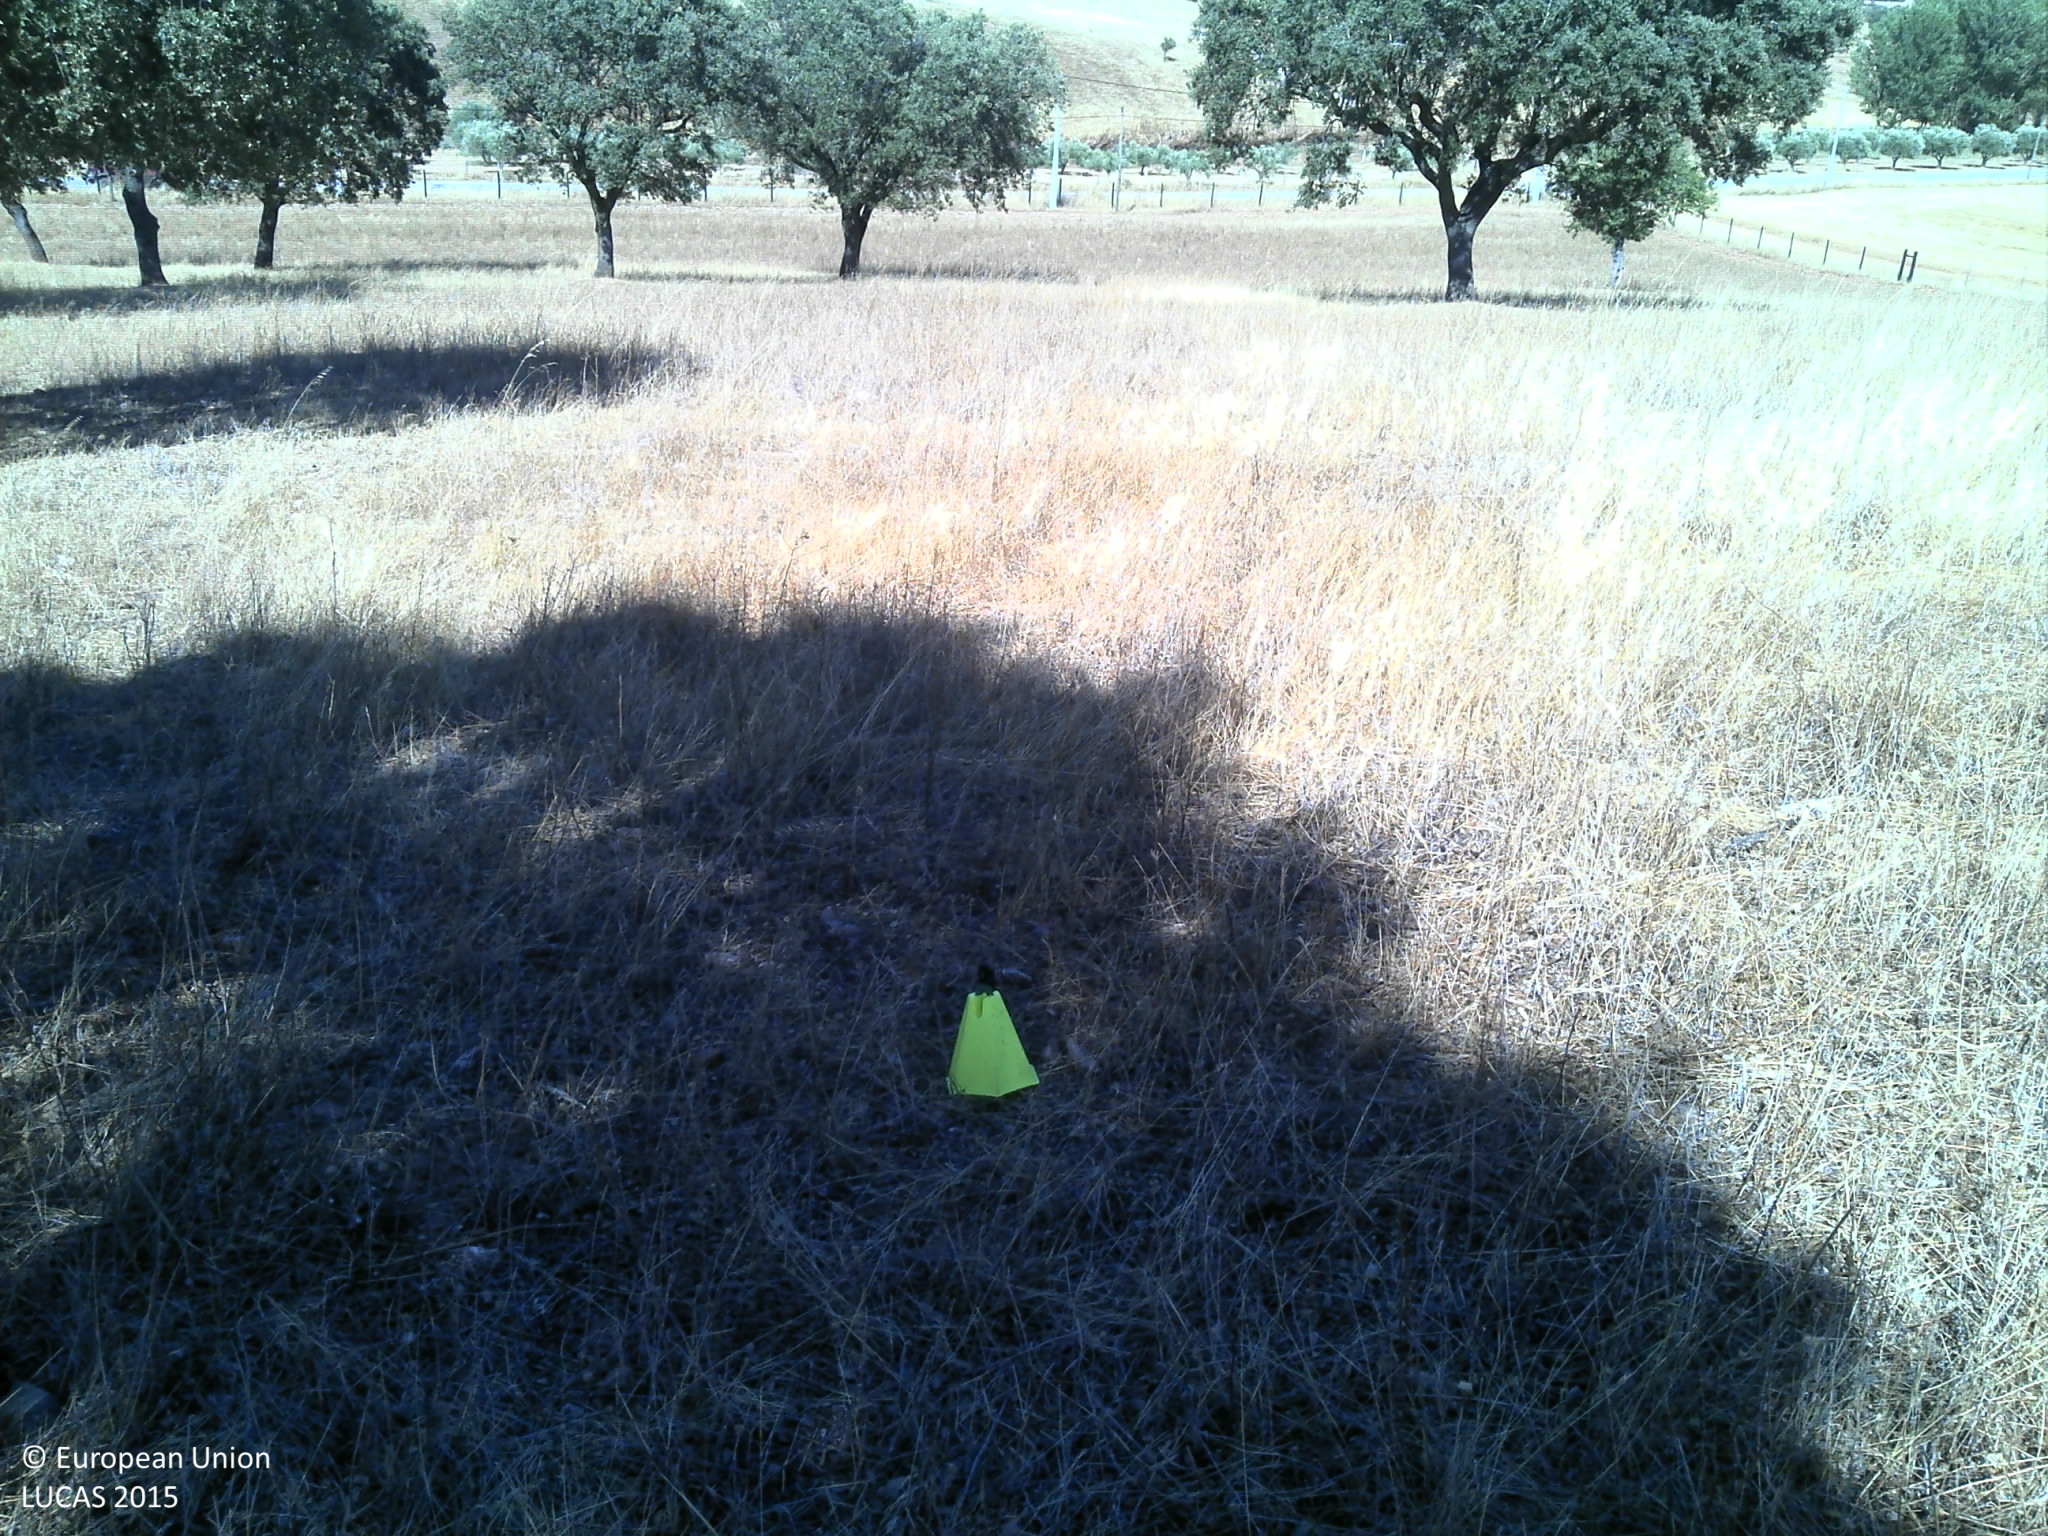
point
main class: Woodland
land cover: Broadleaved woodland
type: broadleaved evergreen forest
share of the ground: 10 - 25 %
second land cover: Grassland without tree/shrub cover
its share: 25 - 50 %
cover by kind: unconsolidated bare surface 50 %, herbaceous plants 30 %, broadleaved forest trees 20 %
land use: Forestry
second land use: Agriculture (excluding fallow land and kitchen gardens)
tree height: > 5 m
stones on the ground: < 10 %
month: July
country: PT
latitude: 38.5410
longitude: -7.4556
